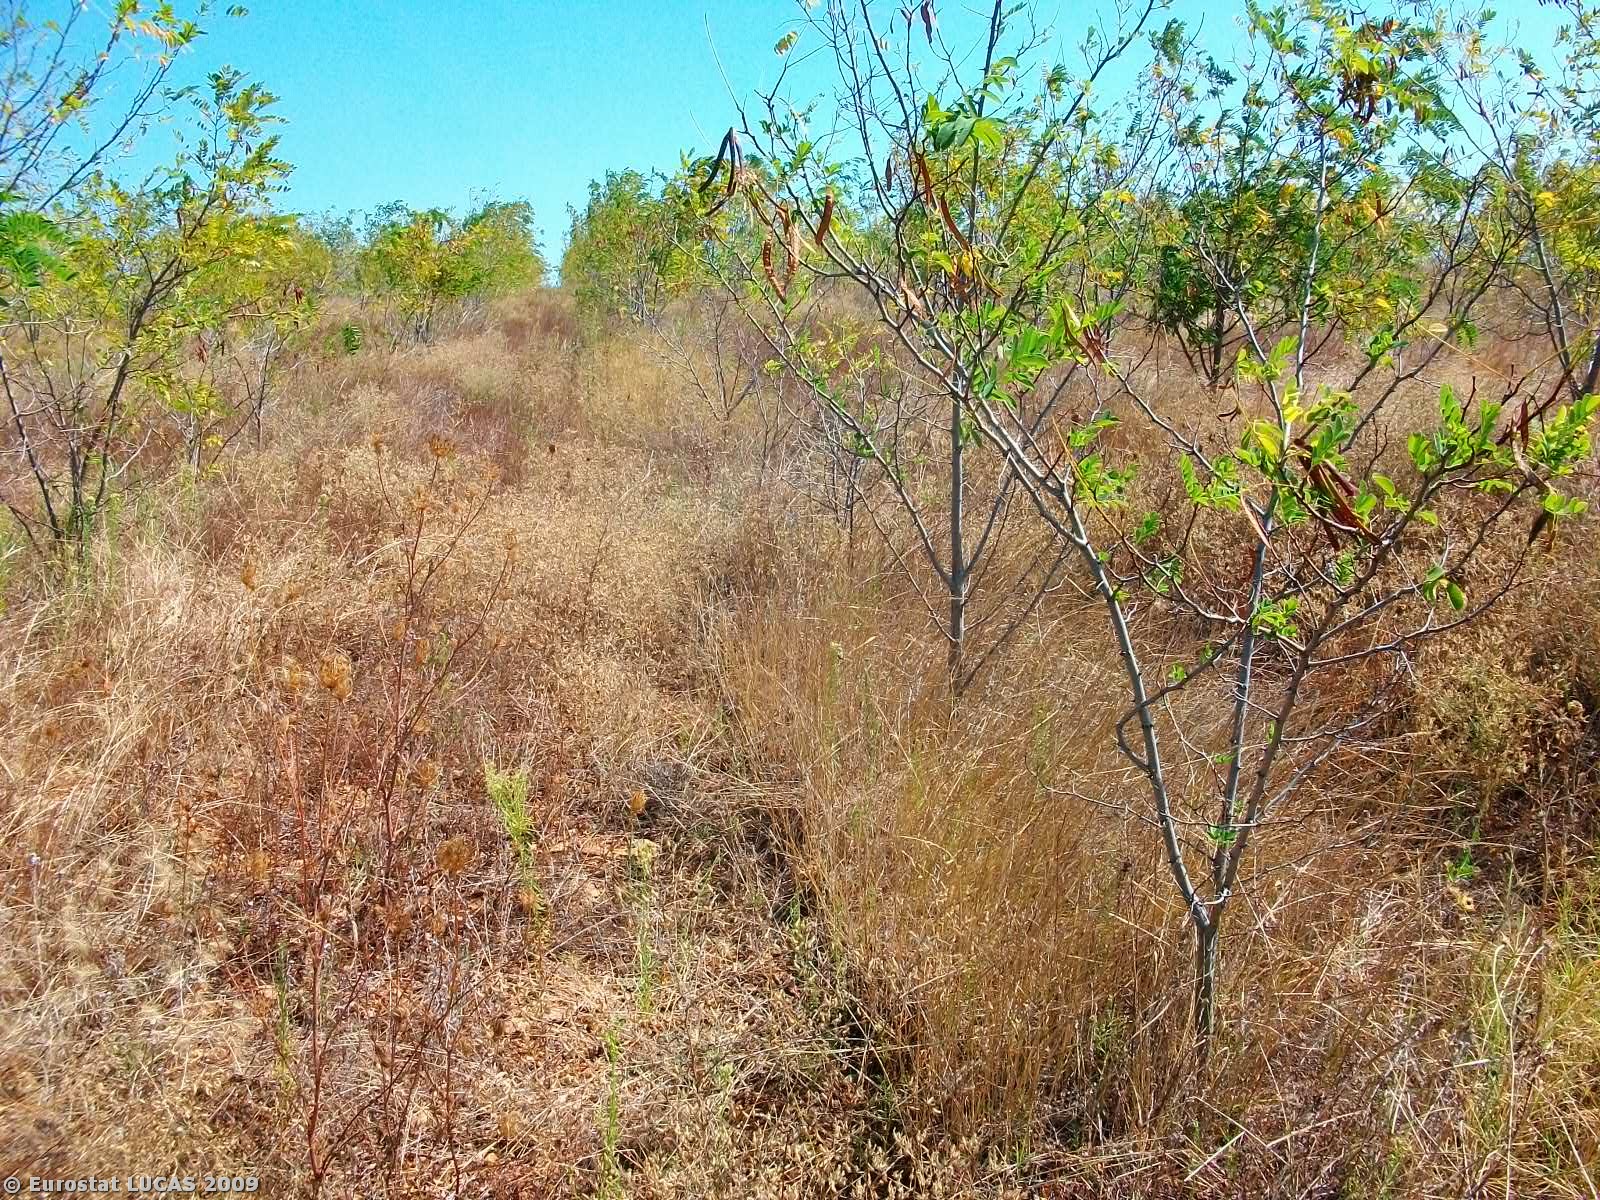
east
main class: Woodland
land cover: Broadleaved woodland
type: plantations and self-sown exotic forest
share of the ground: 25 - 50 %
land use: Forestry
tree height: > 5 m
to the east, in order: Broadleaved woodland; Grass margins; Tracks; Grass margins; Cotton
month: September
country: GR
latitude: 41.3396
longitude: 26.3123
